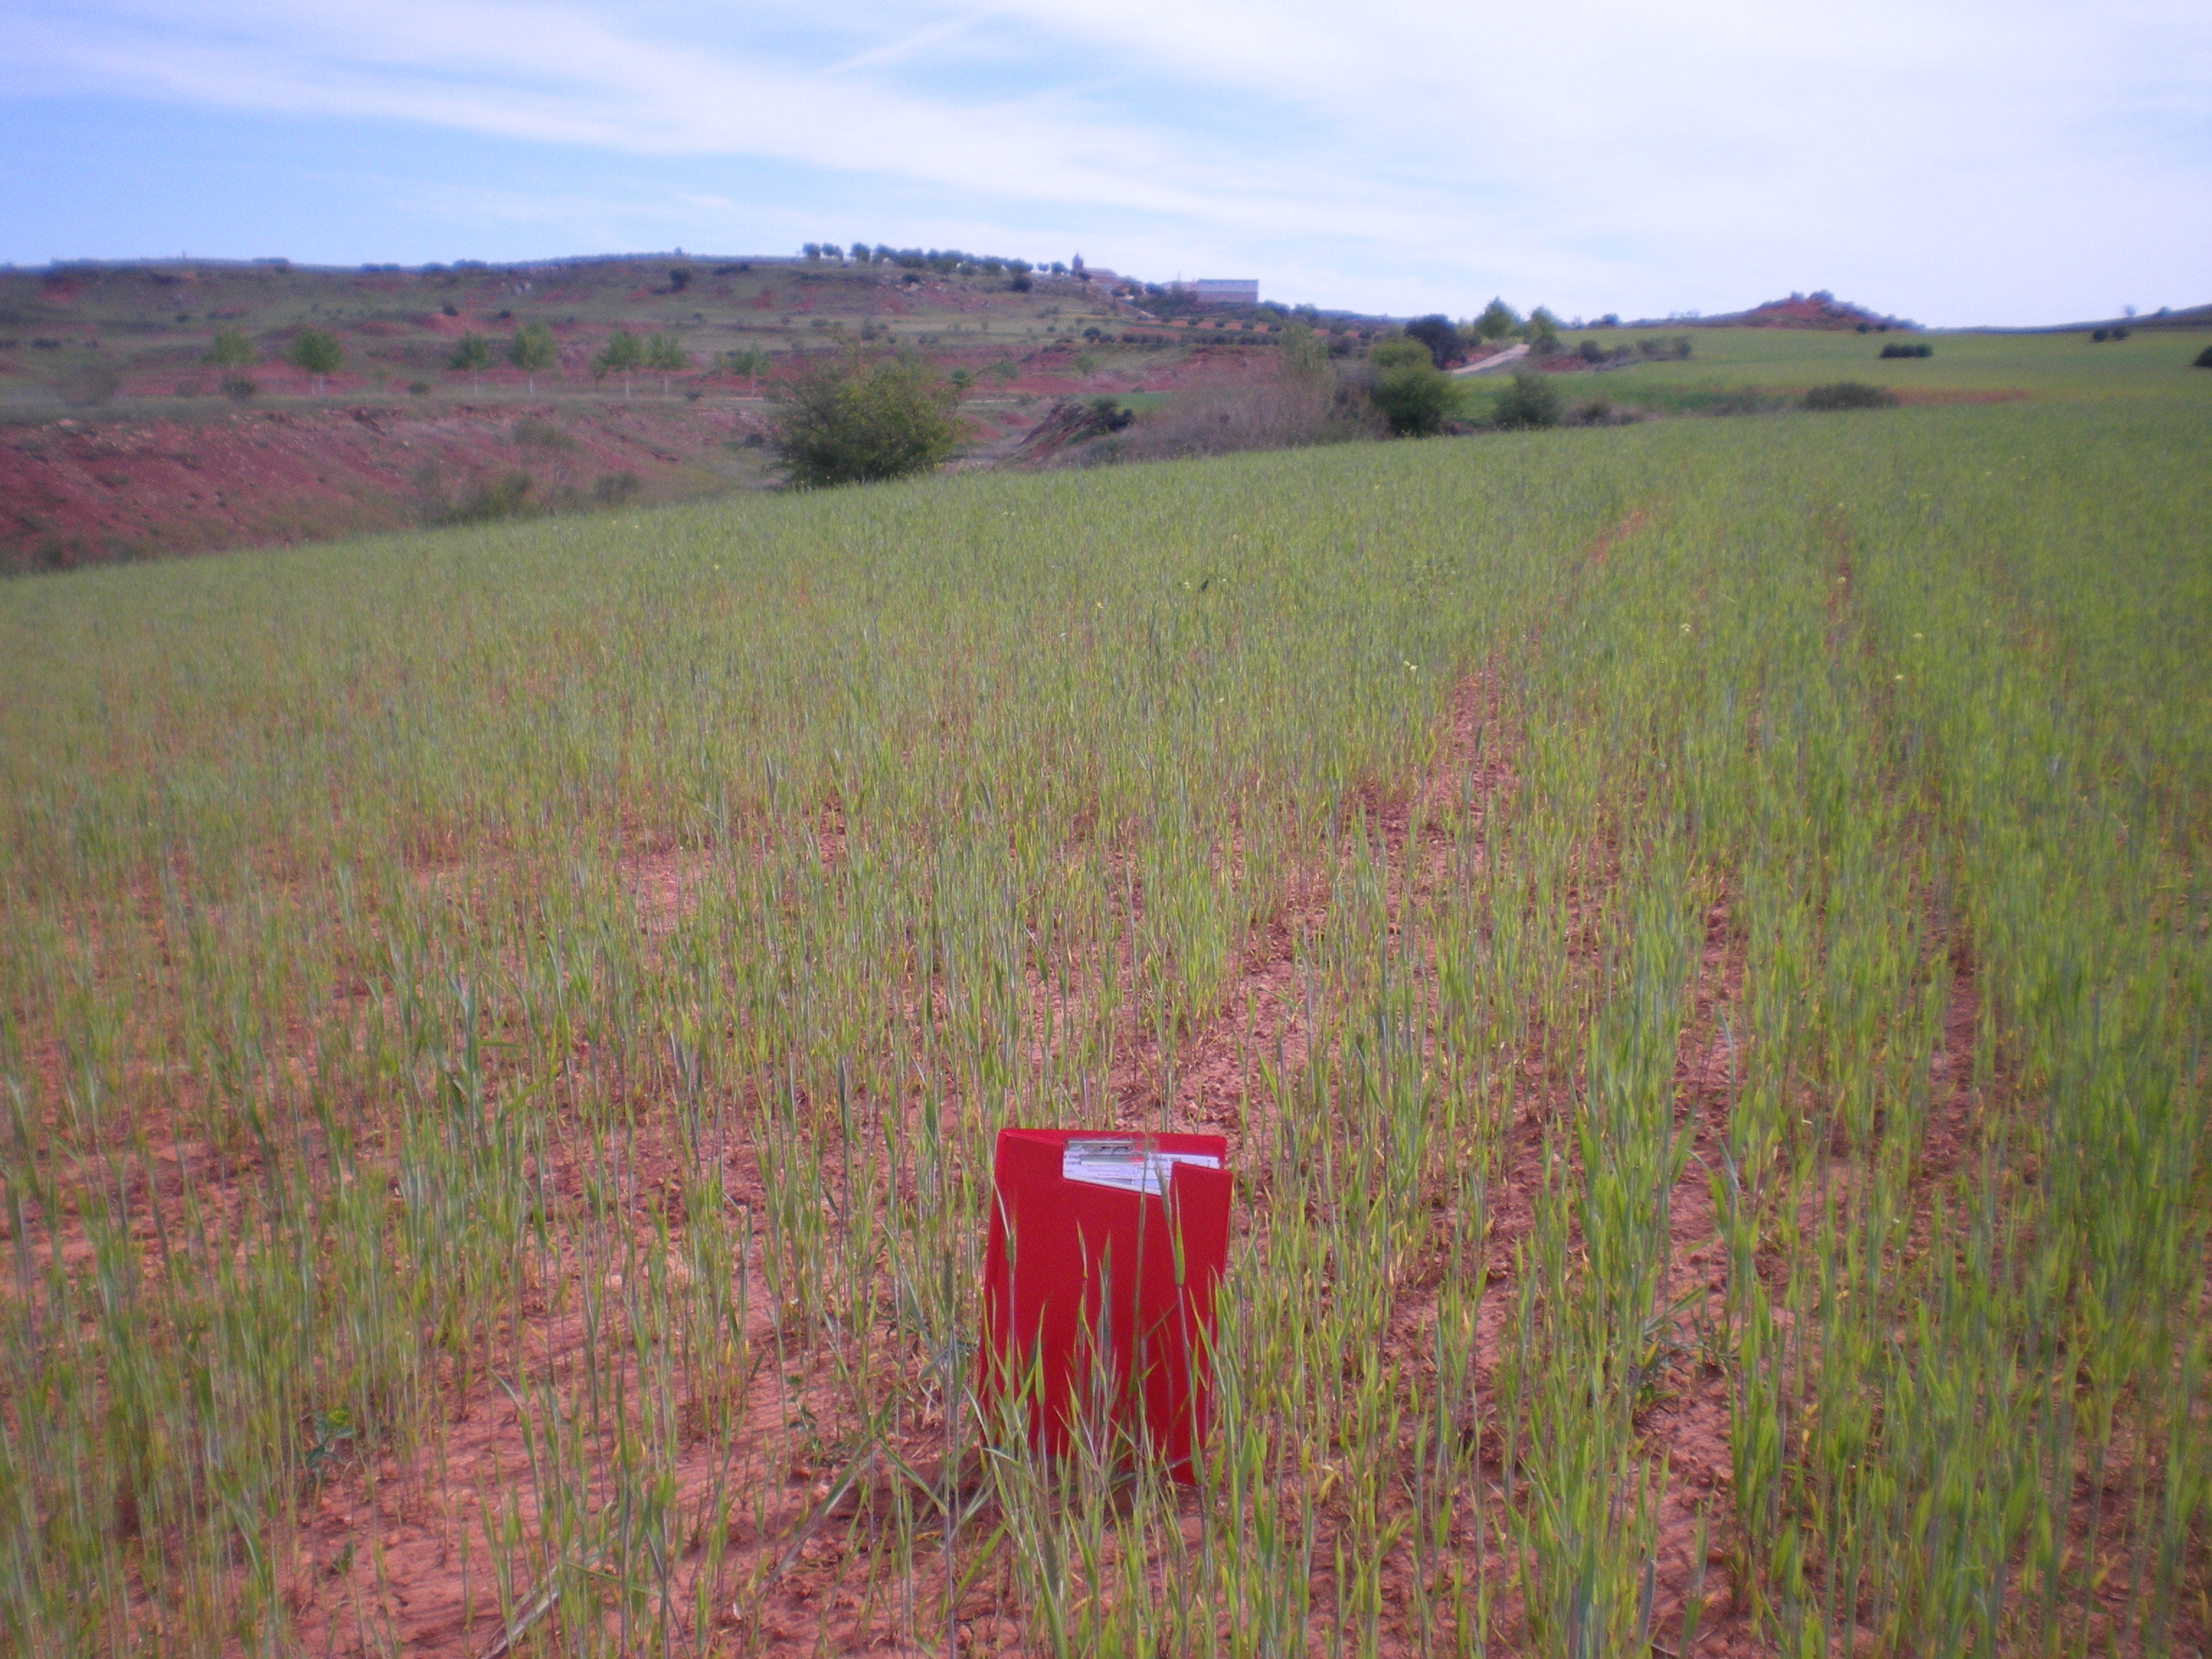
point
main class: Cropland
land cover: Durum wheat
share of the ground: 50 - 75 %
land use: Agriculture (excluding fallow land and kitchen gardens)
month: April
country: ES
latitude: 38.6150
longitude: -2.9710
